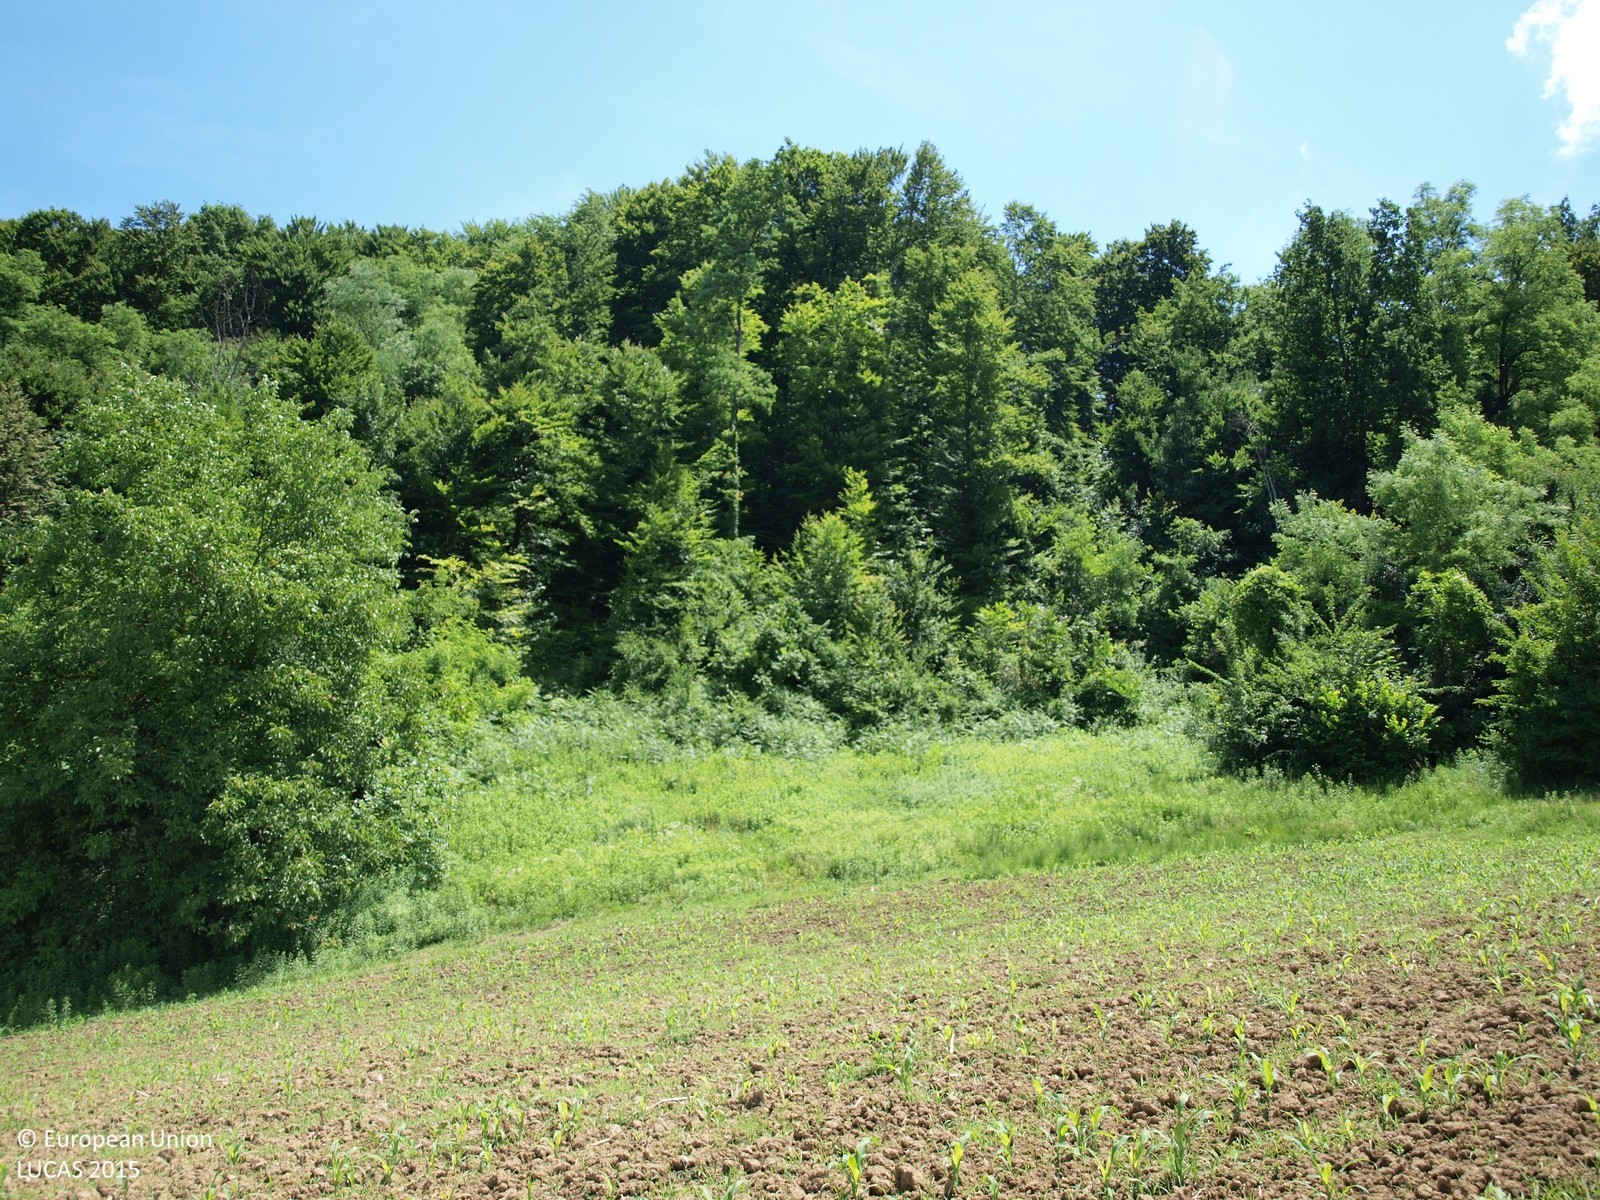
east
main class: Cropland
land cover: Maize
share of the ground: 25 - 50 %
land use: Agriculture (excluding fallow land and kitchen gardens)
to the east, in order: Maize; Broadleaved woodland
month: June
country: HR
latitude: 46.0908
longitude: 15.7018
